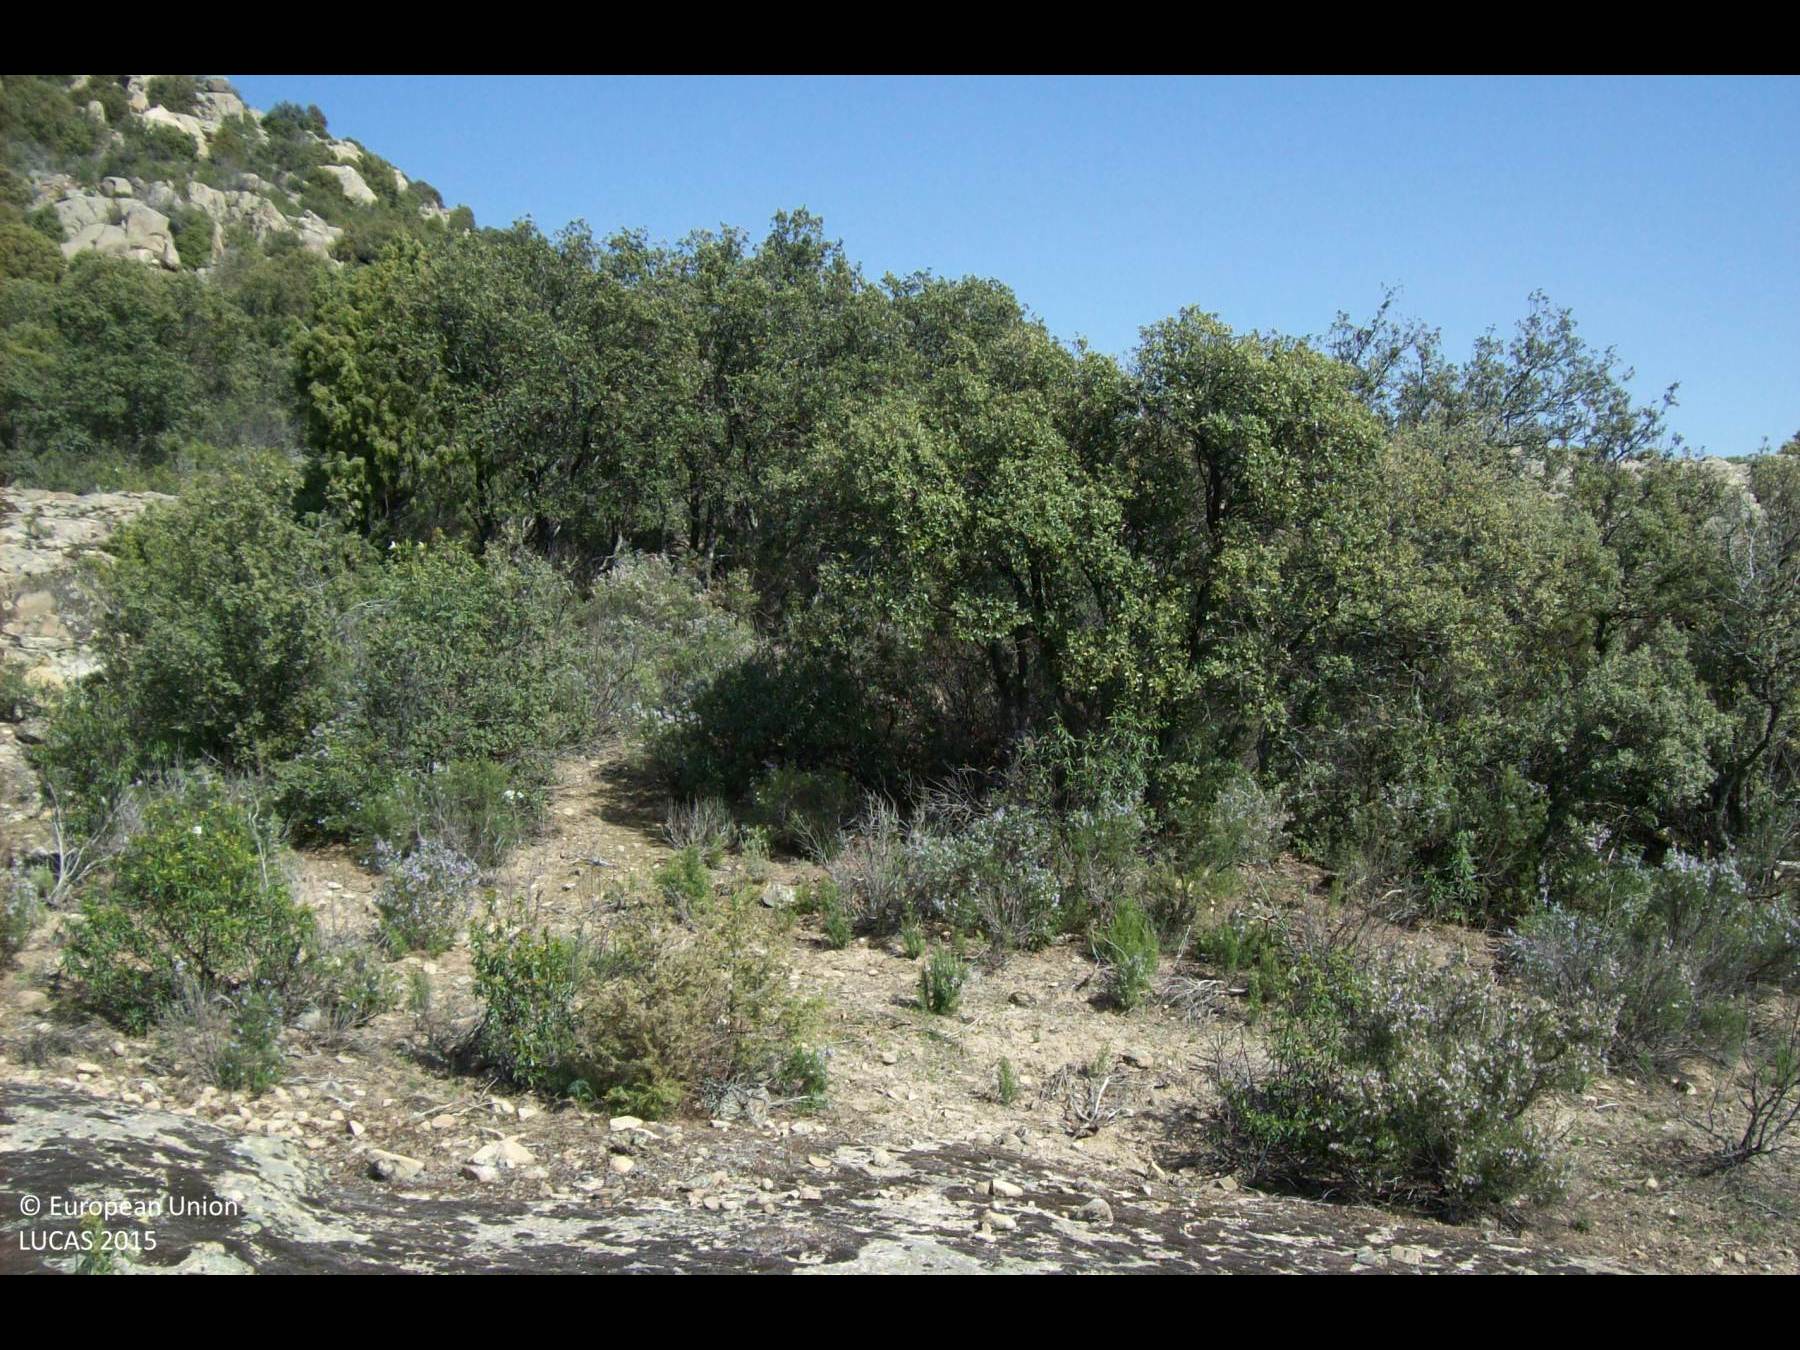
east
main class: Shrubland
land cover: Shrubland with sparse tree cover
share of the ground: 25 - 50 %
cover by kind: shrubs 45 %, consolidated bare surface 45 %, broadleaved forest trees 5 %, herbaceous plants 5 %
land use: Semi-natural and natural areas not in use
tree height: < 5 m
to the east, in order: Shrubland with sparse tree cover; Rocks and stones; Rock outcrops; Shrubland with sparse tree cover; Tracks; Shrubland with sparse tree cover; Rock outcrops; Shrubland with sparse tree cover
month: April
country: ES
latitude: 40.6237
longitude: -3.9337
